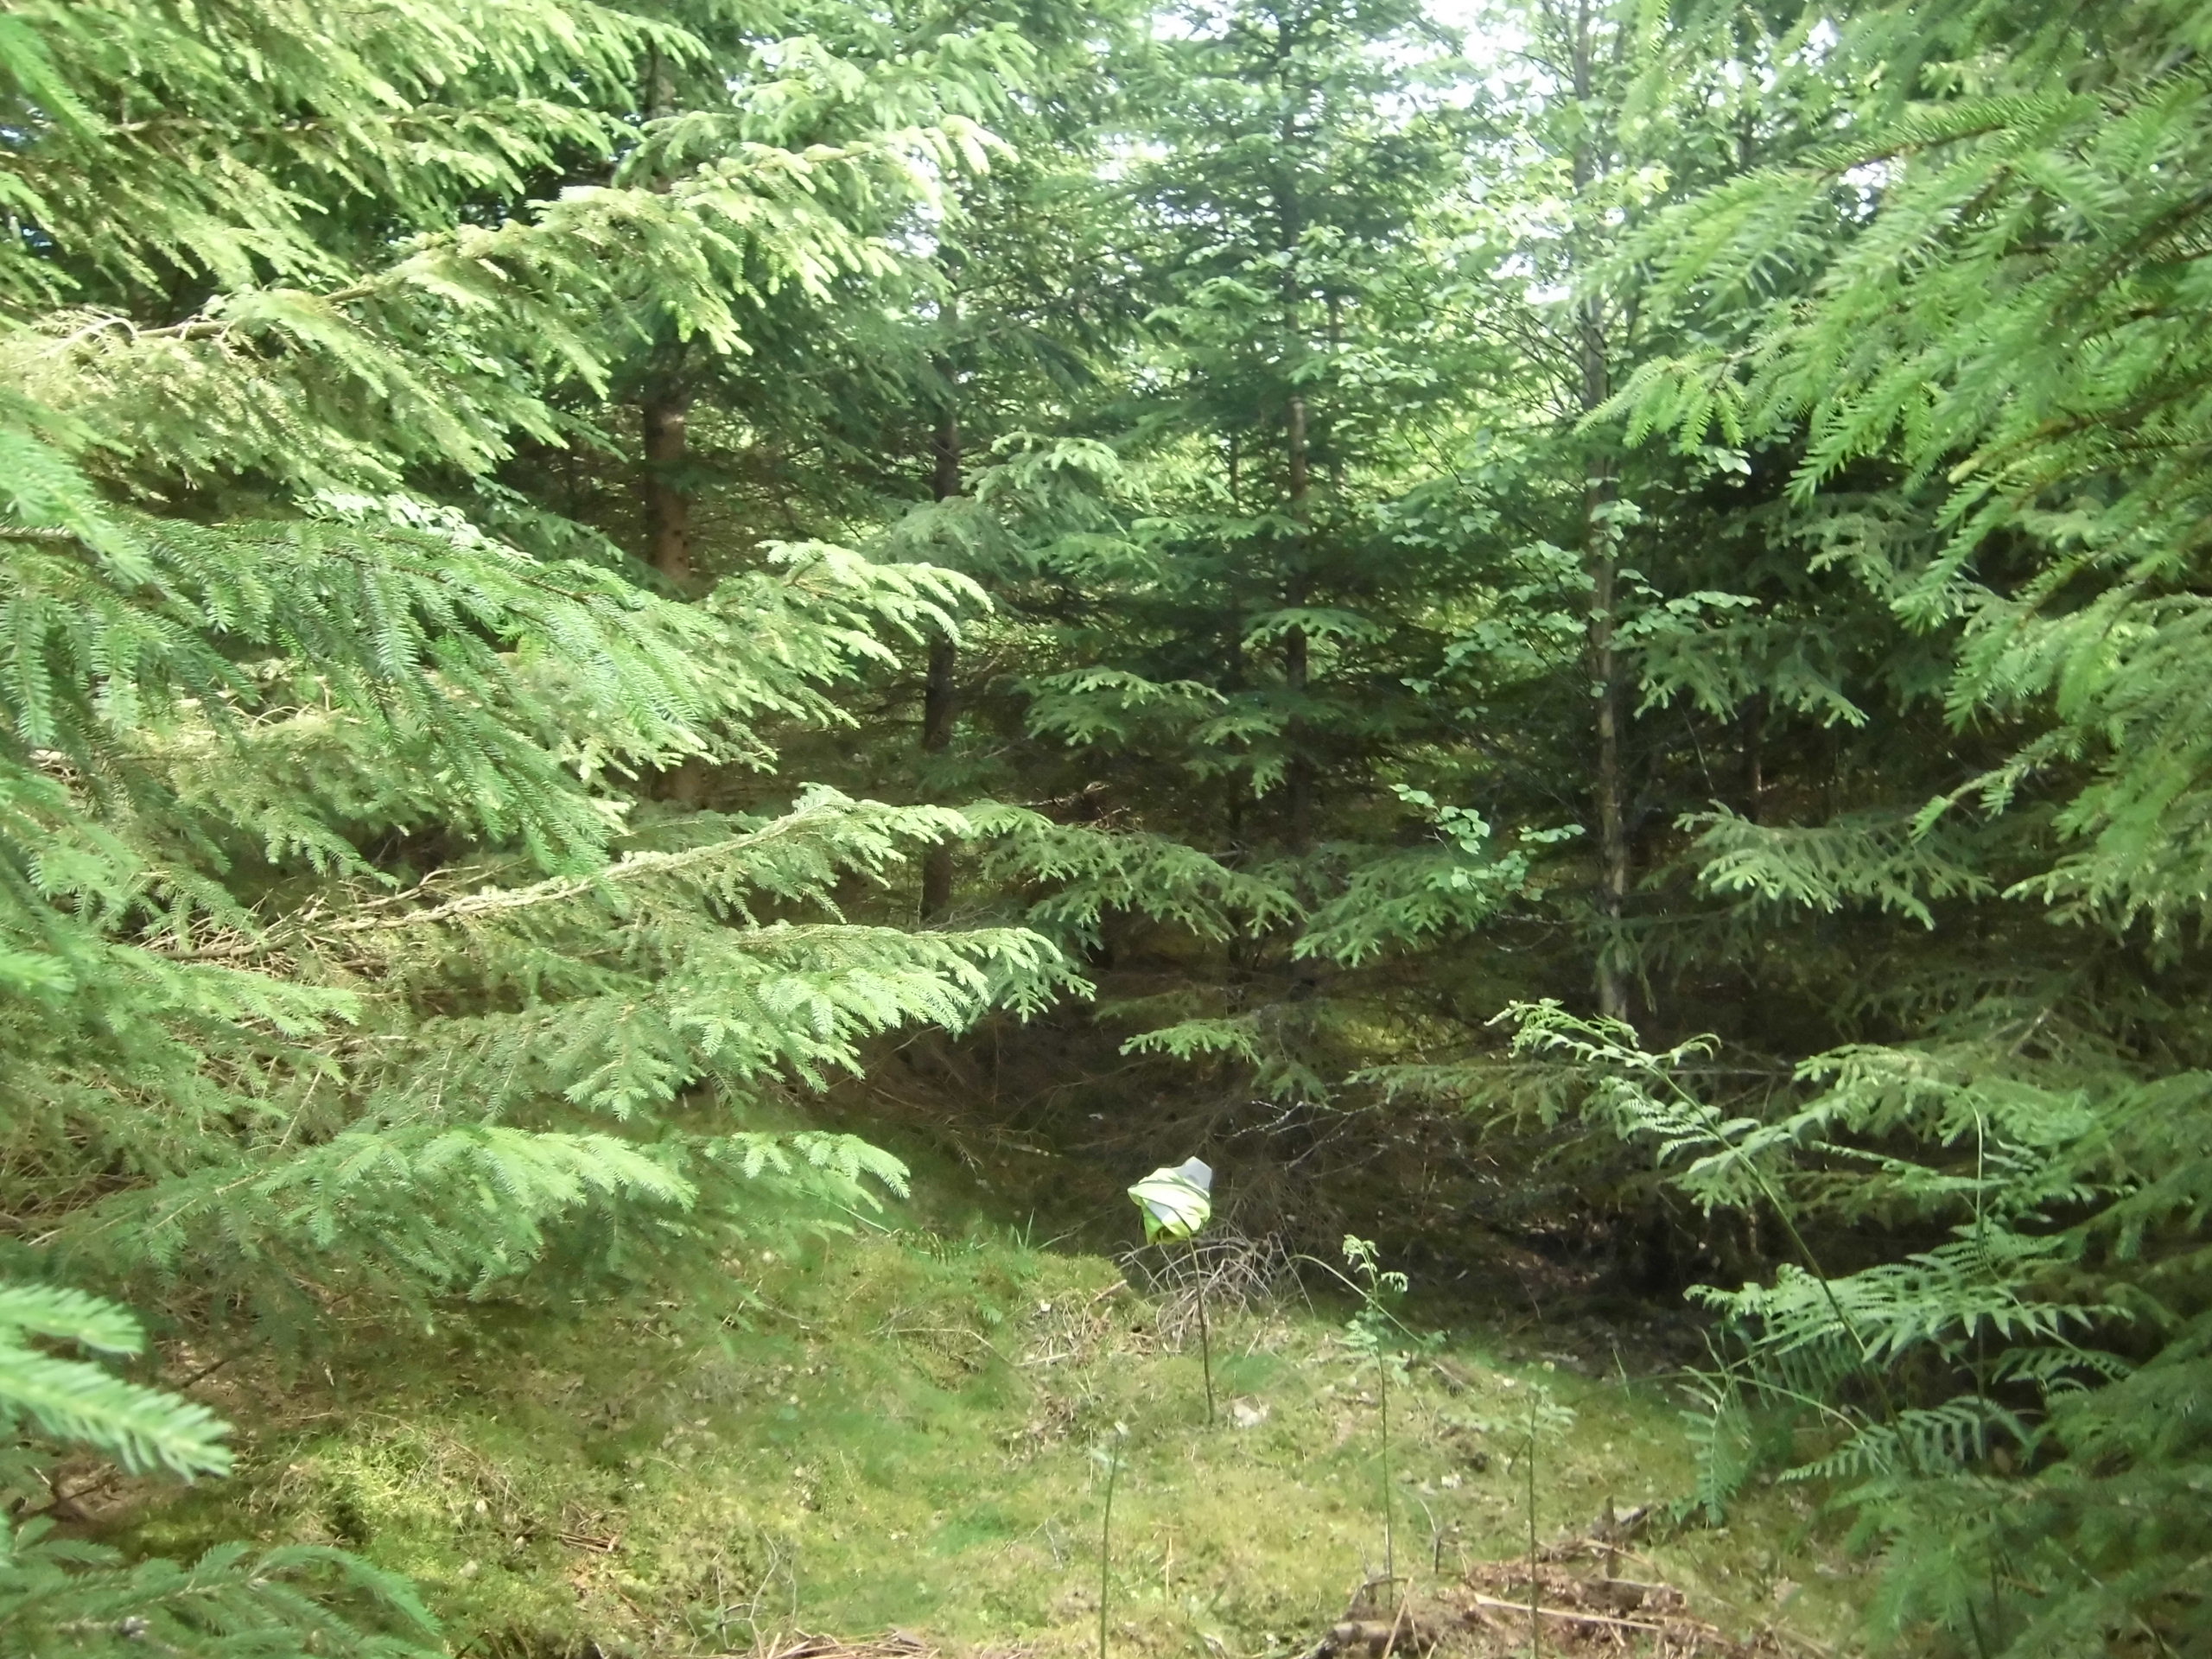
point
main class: Woodland
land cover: Spruce dominated coniferous woodland
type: boreal forest
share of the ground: > 75 %
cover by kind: coniferous forest trees 75 %, lichens and mosses 15 %, broadleaved forest trees 5 %, herbaceous plants 5 %
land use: Forestry
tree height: > 5 m
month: July
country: SE
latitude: 57.2465
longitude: 14.9186
